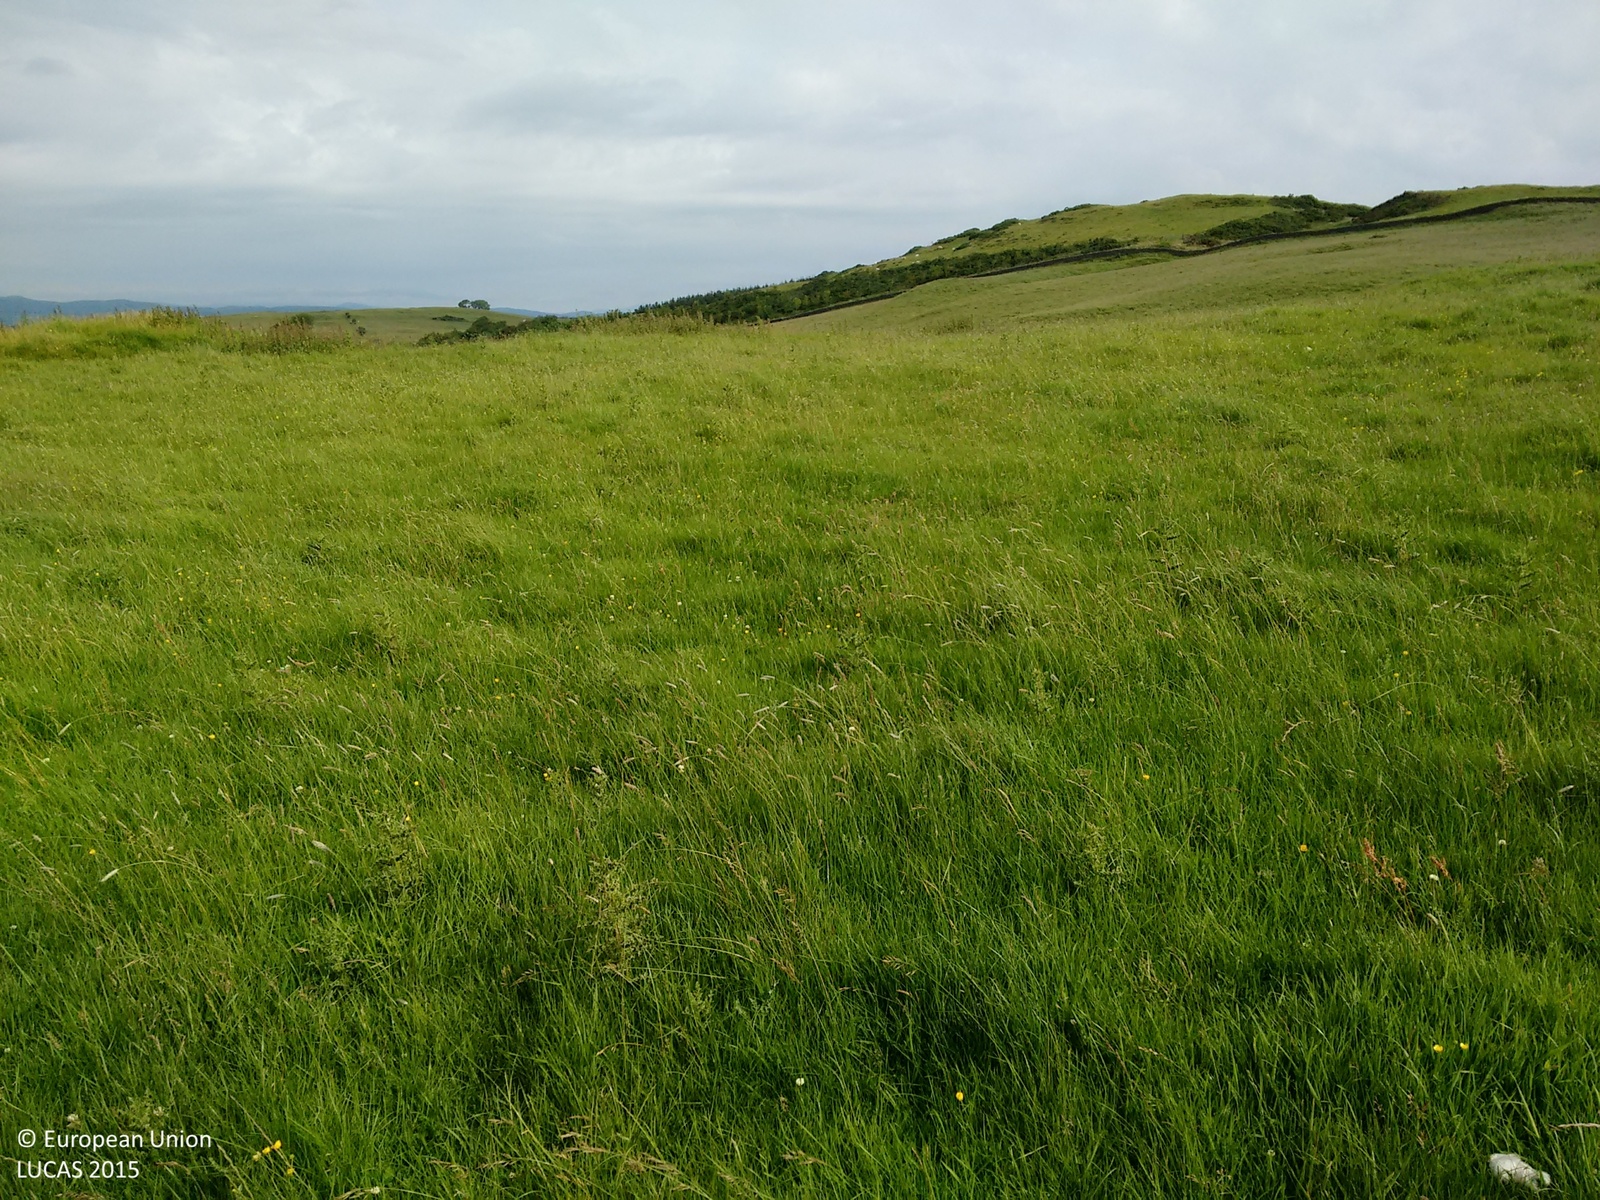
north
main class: Grassland
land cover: Grassland without tree/shrub cover
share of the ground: > 75 %
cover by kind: herbaceous plants 100 %
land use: Agriculture (excluding fallow land and kitchen gardens)
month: July
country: GB
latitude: 54.8133
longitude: -3.9868
